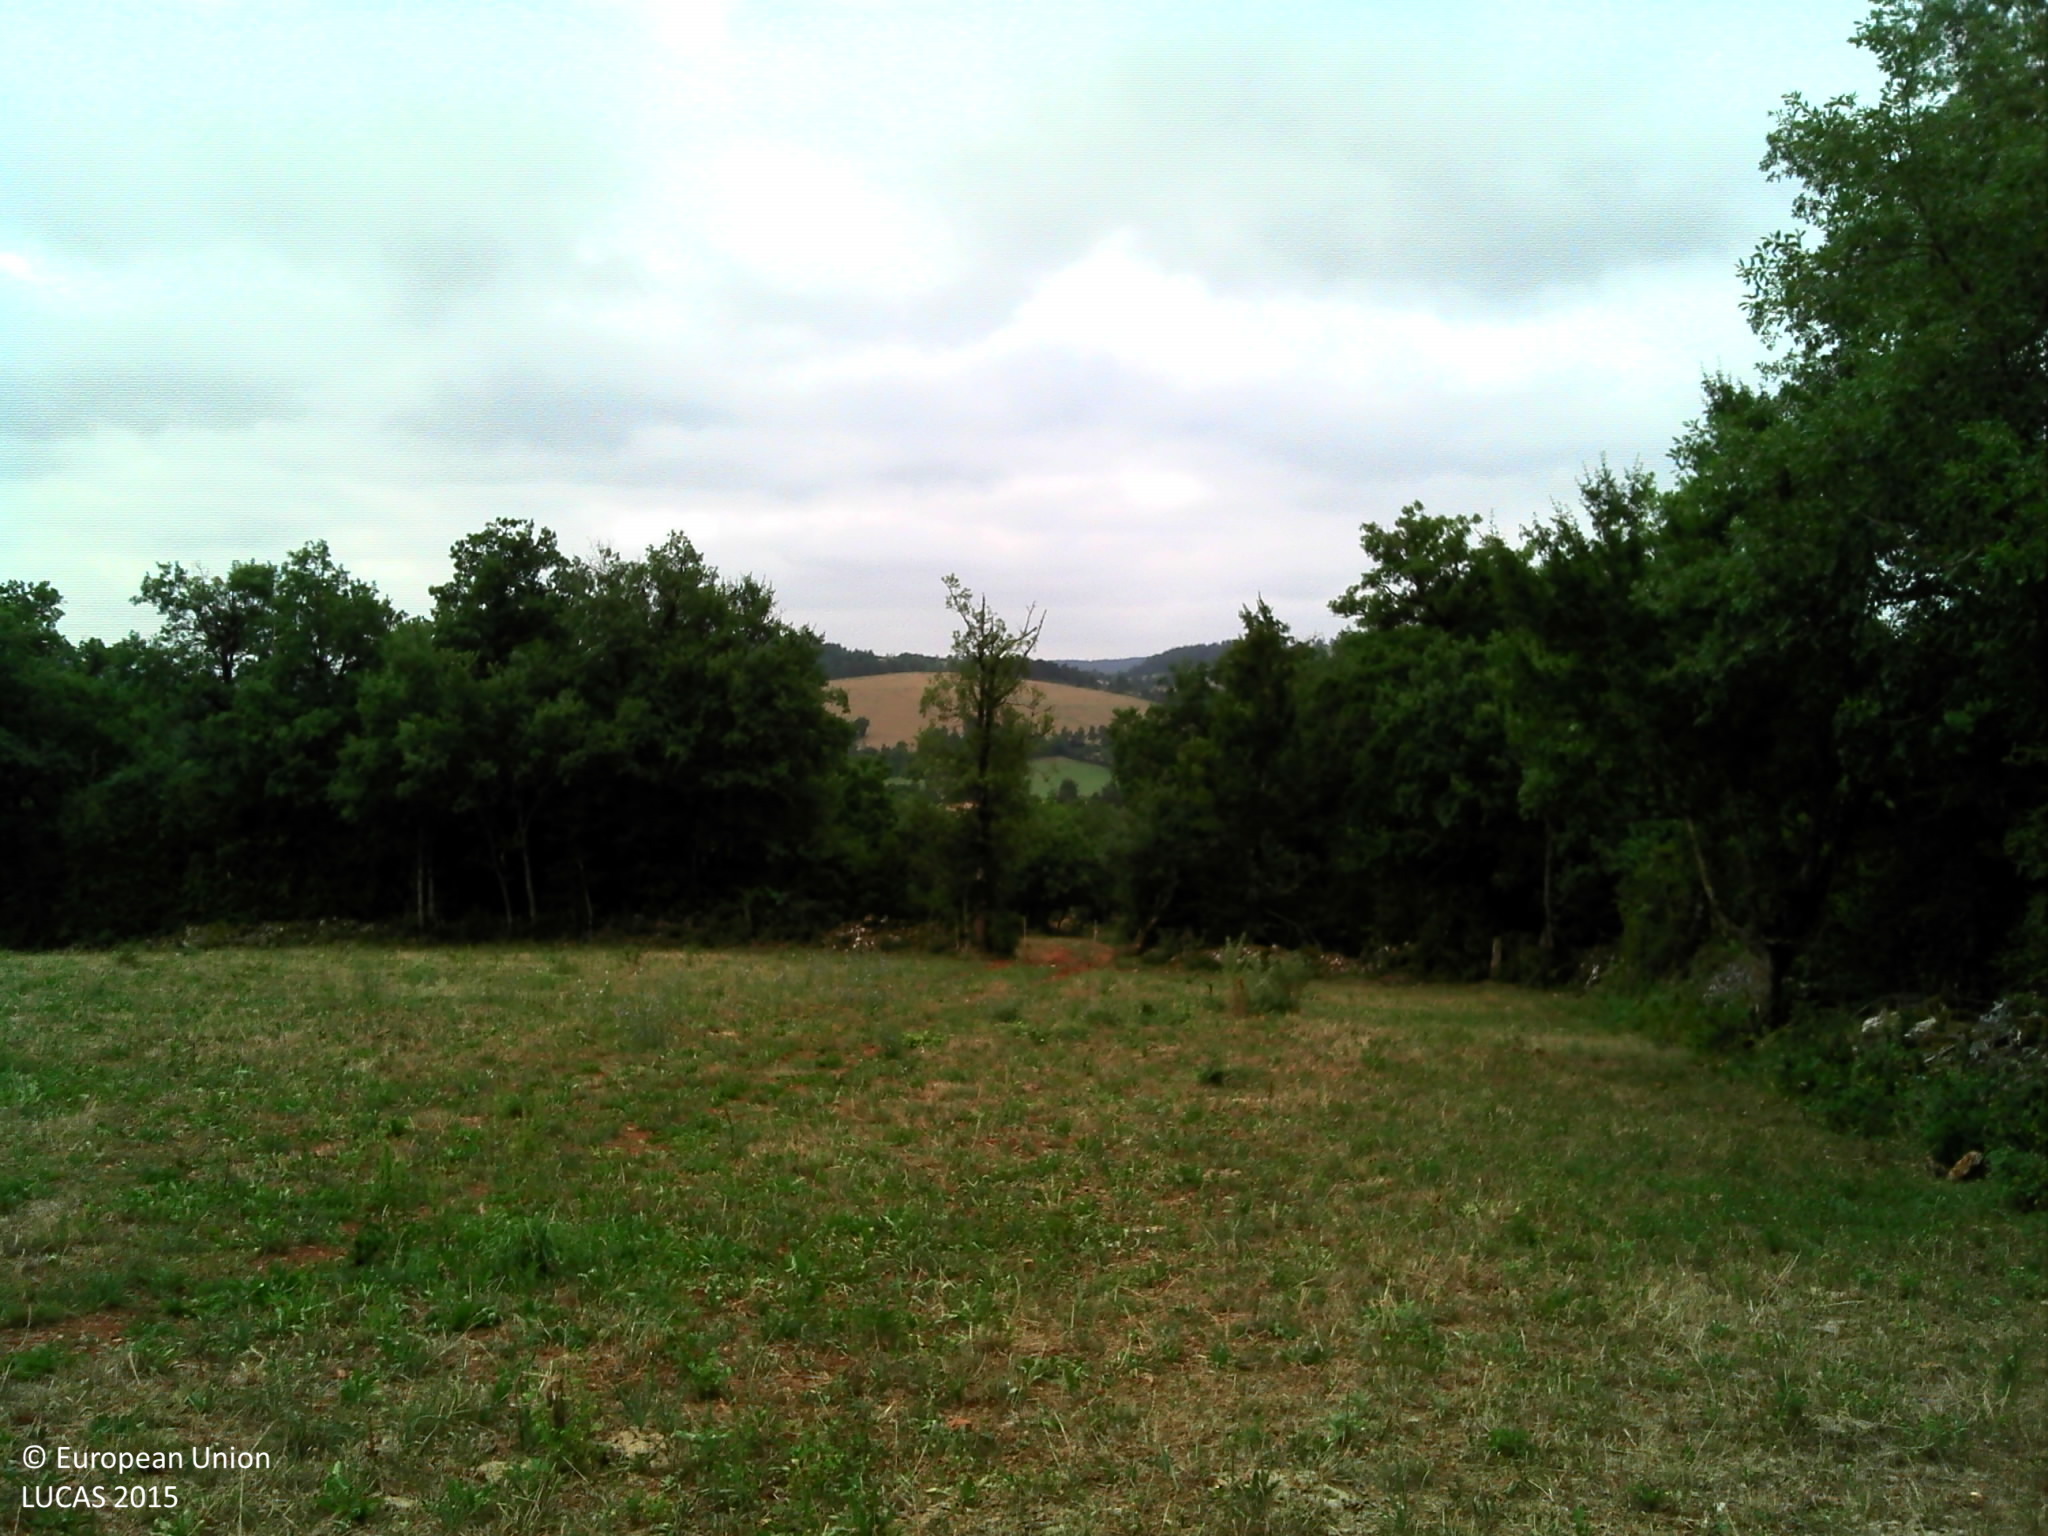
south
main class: Grassland
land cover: Spontaneously vegetated surfaces
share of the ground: 50 - 75 %
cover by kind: herbaceous plants 100 %
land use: Agriculture (excluding fallow land and kitchen gardens)
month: July
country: FR
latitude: 44.3930
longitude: 3.1126
